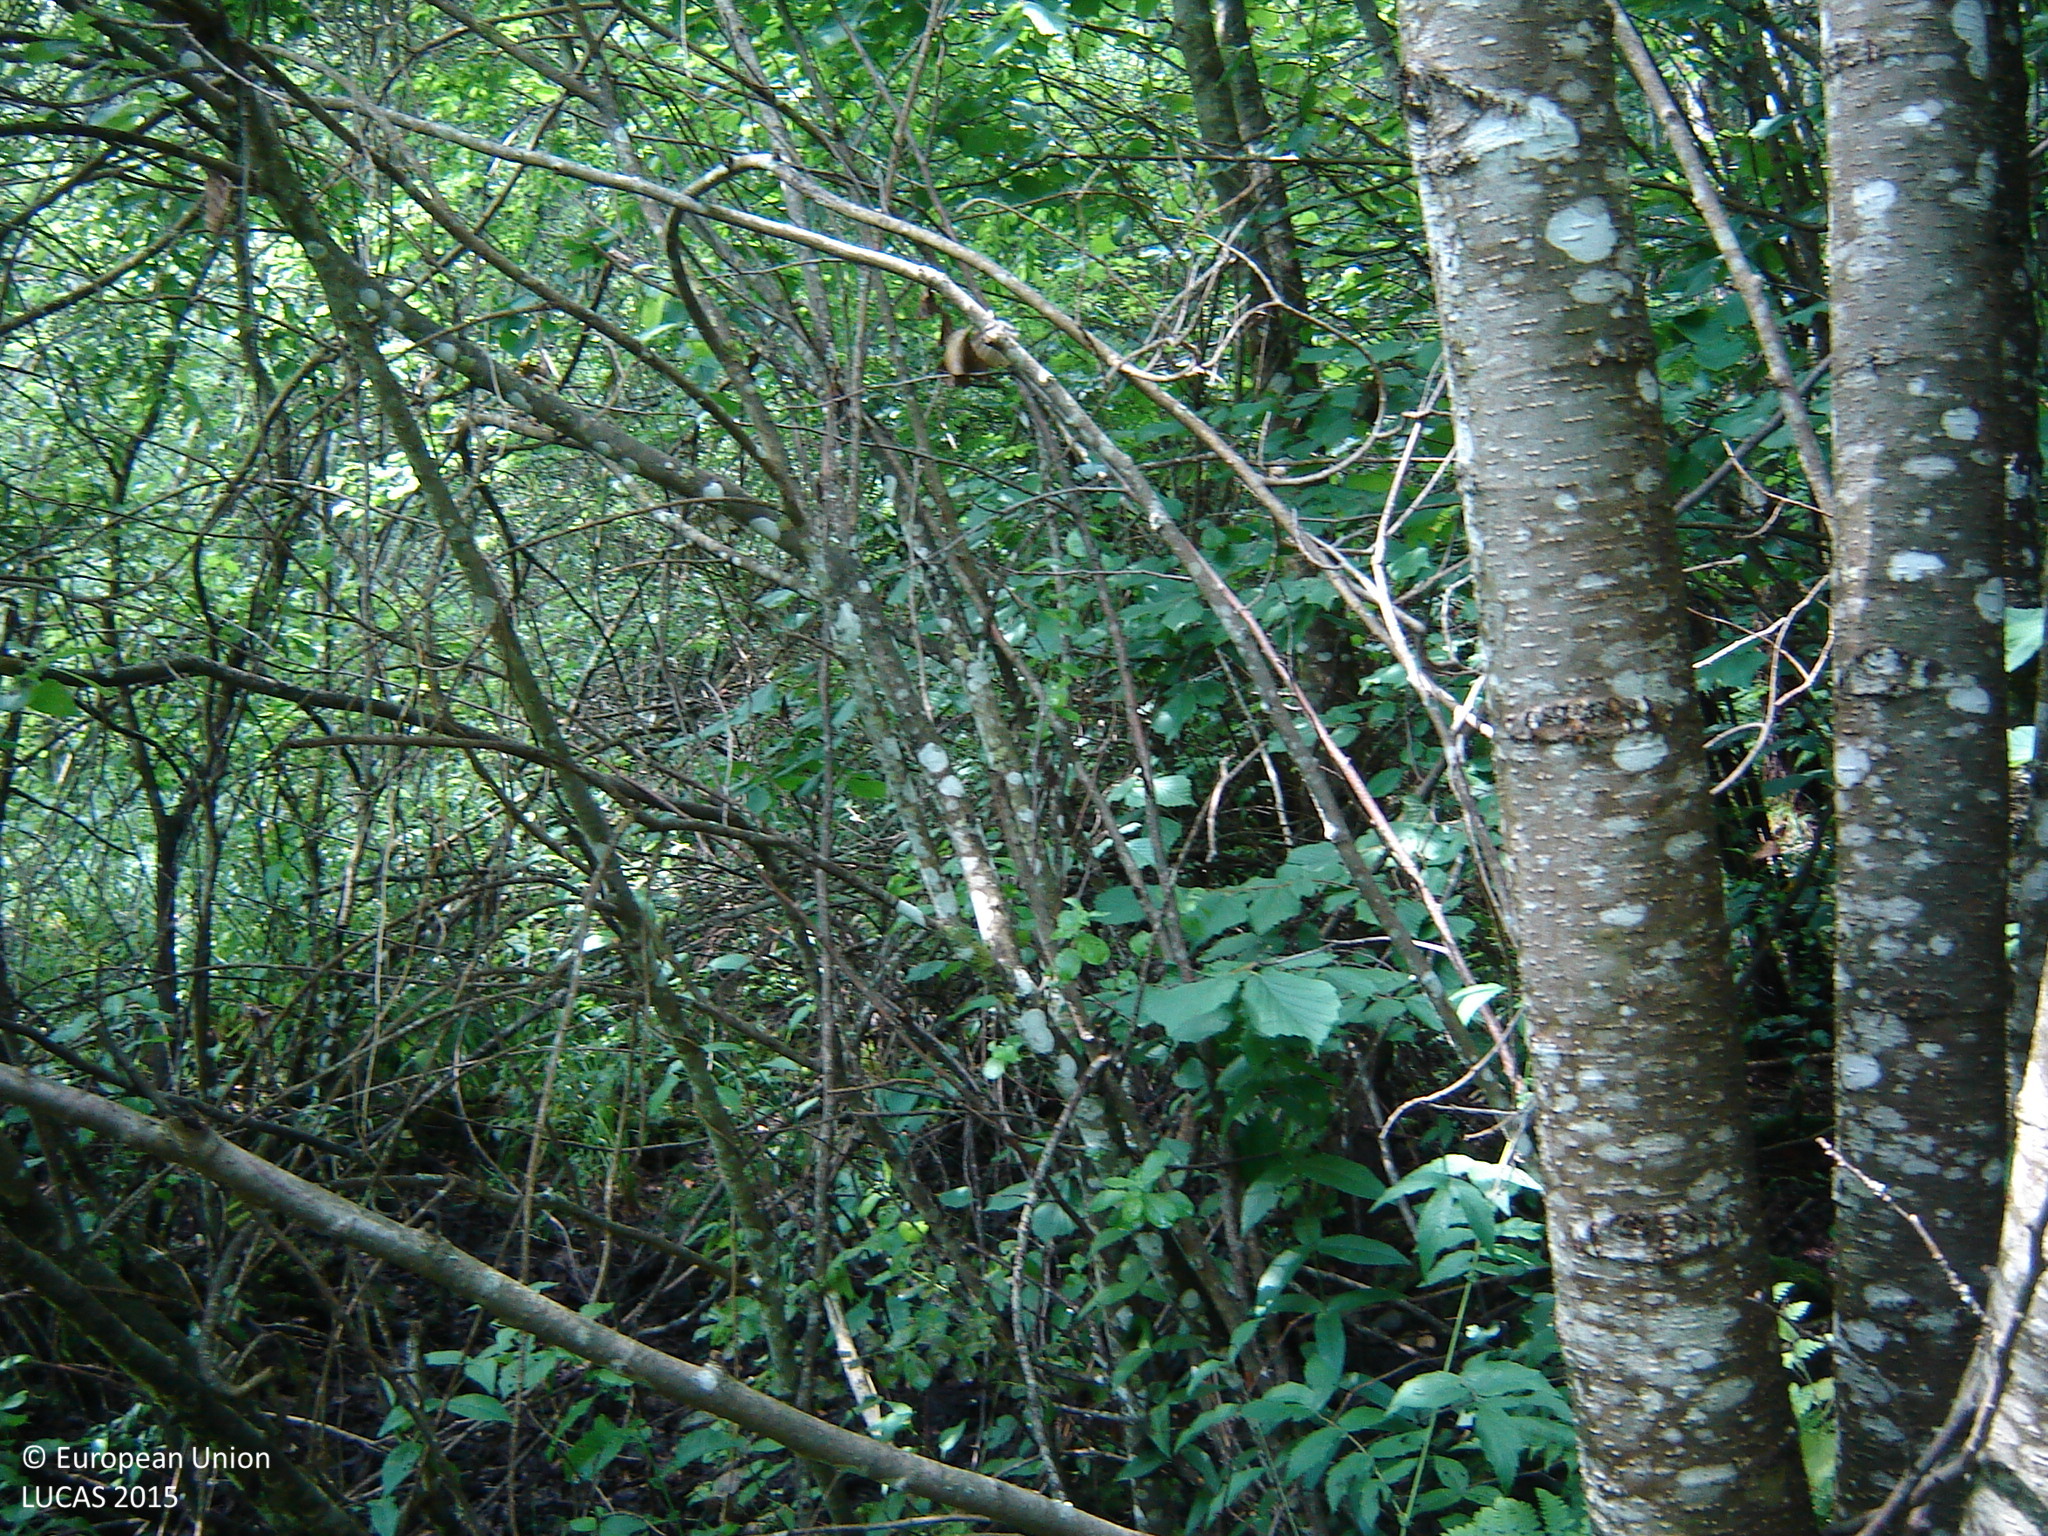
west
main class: Woodland
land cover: Broadleaved woodland
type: mire and swamp forests
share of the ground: > 75 %
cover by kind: broadleaved forest trees 80 %, herbaceous plants 20 %
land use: Forestry
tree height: > 5 m
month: July
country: LT
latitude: 55.4243
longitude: 25.1741
